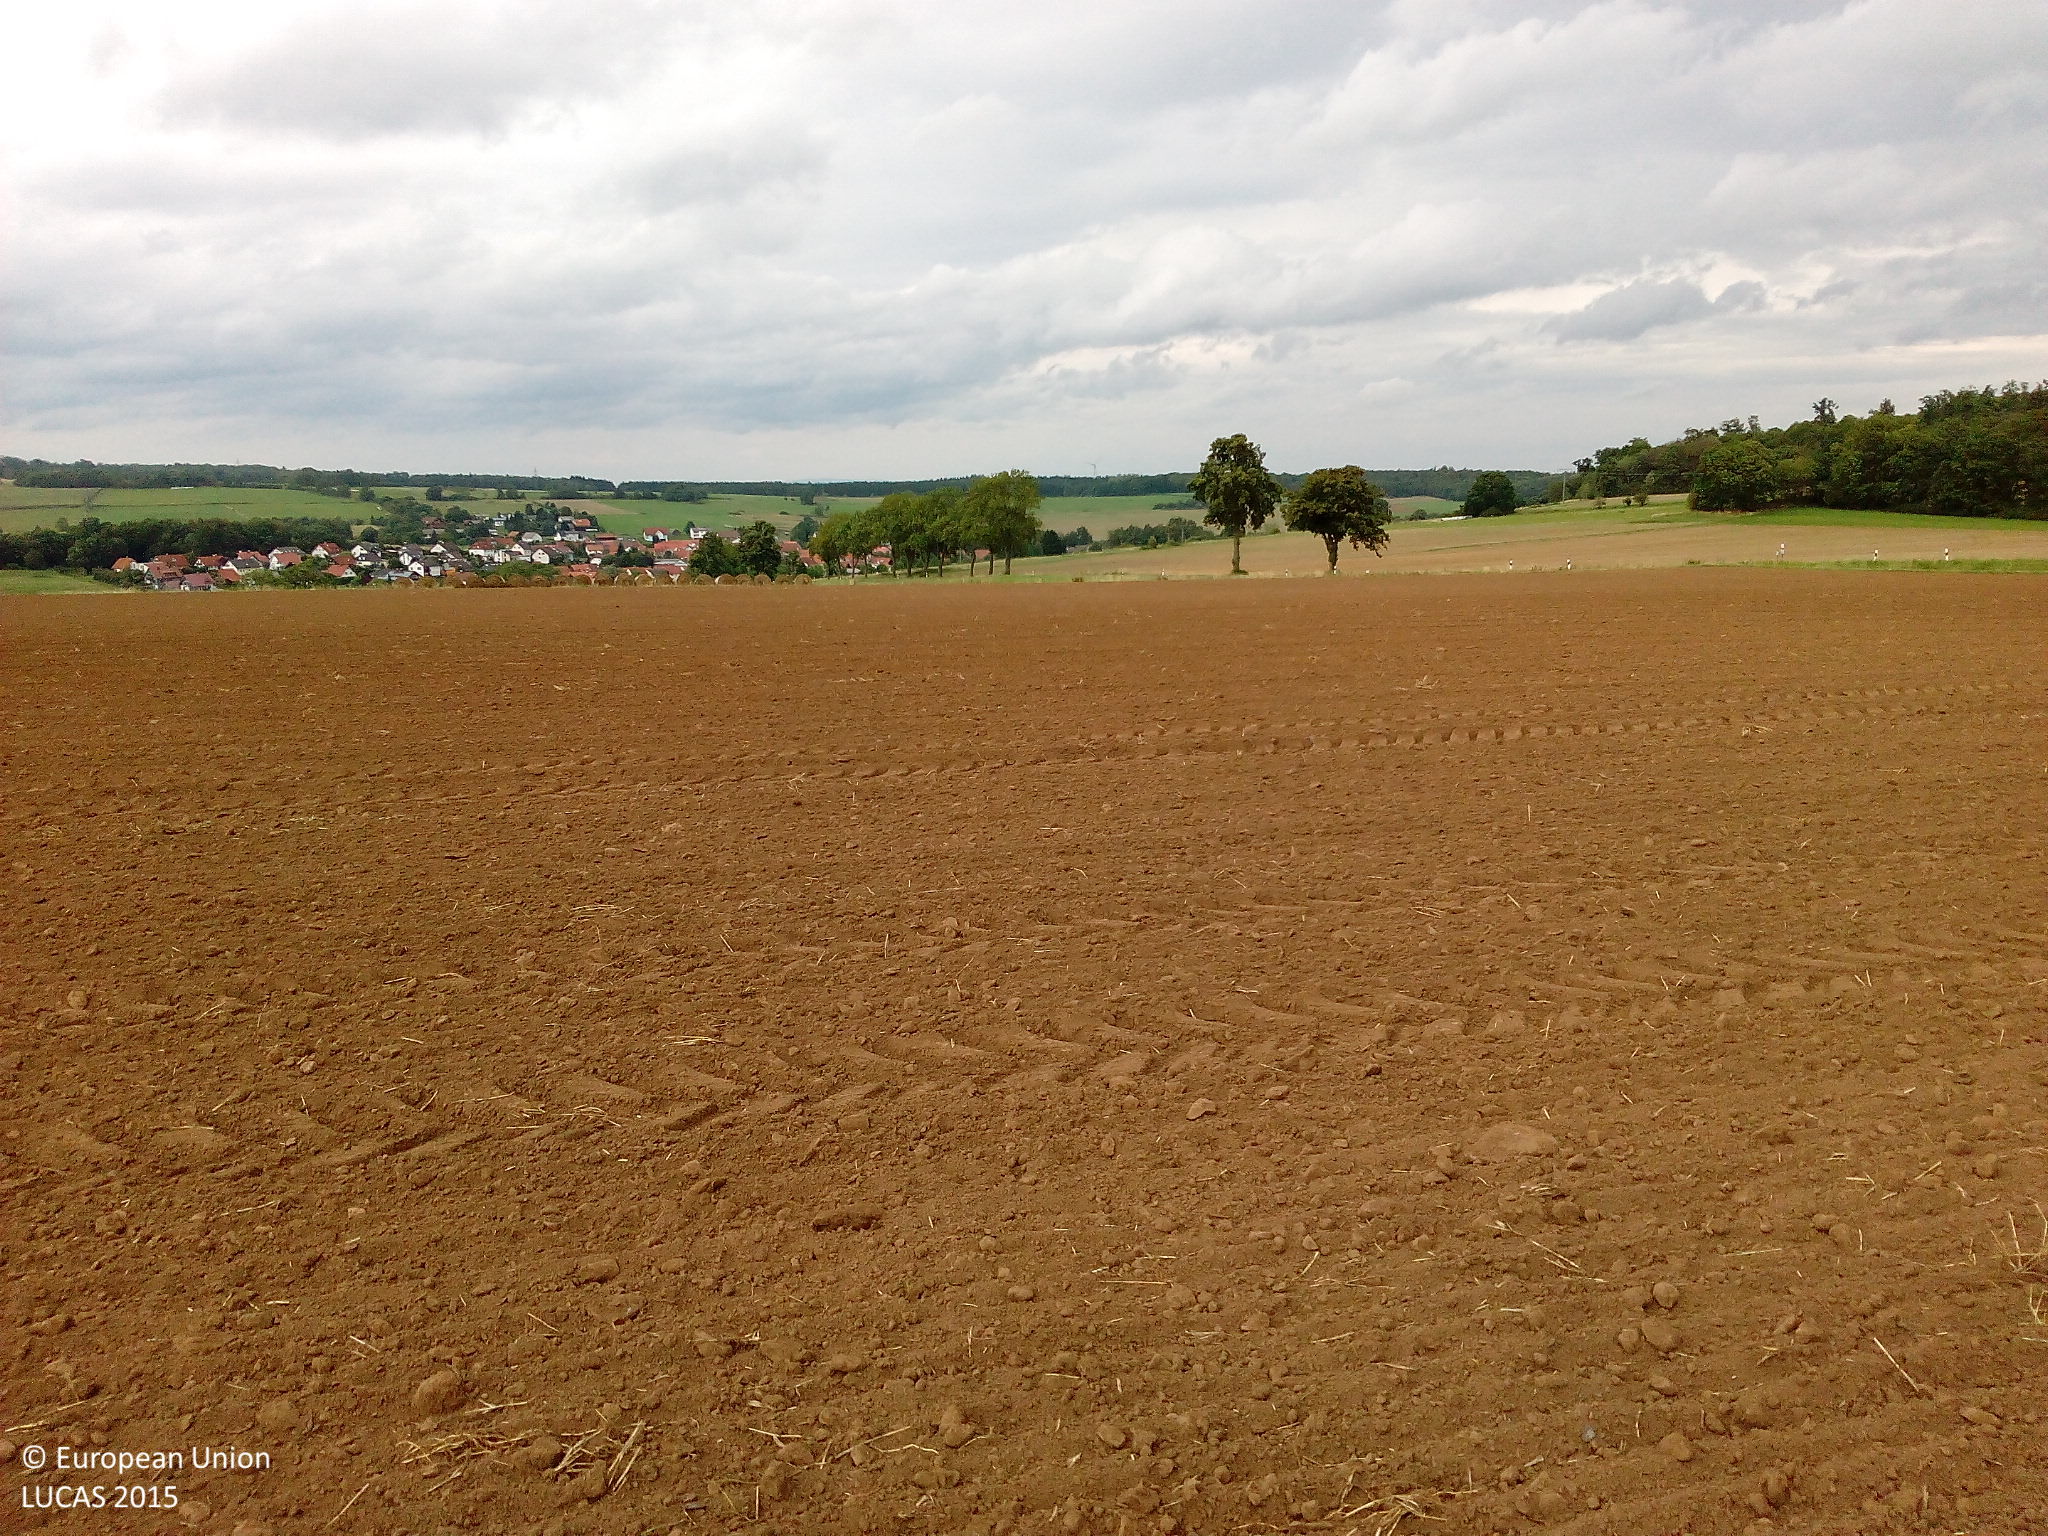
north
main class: Grassland
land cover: Grassland without tree/shrub cover
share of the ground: > 75 %
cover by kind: herbaceous plants 100 %
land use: Agriculture (excluding fallow land and kitchen gardens)
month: August
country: DE
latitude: 50.5957
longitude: 9.3080
